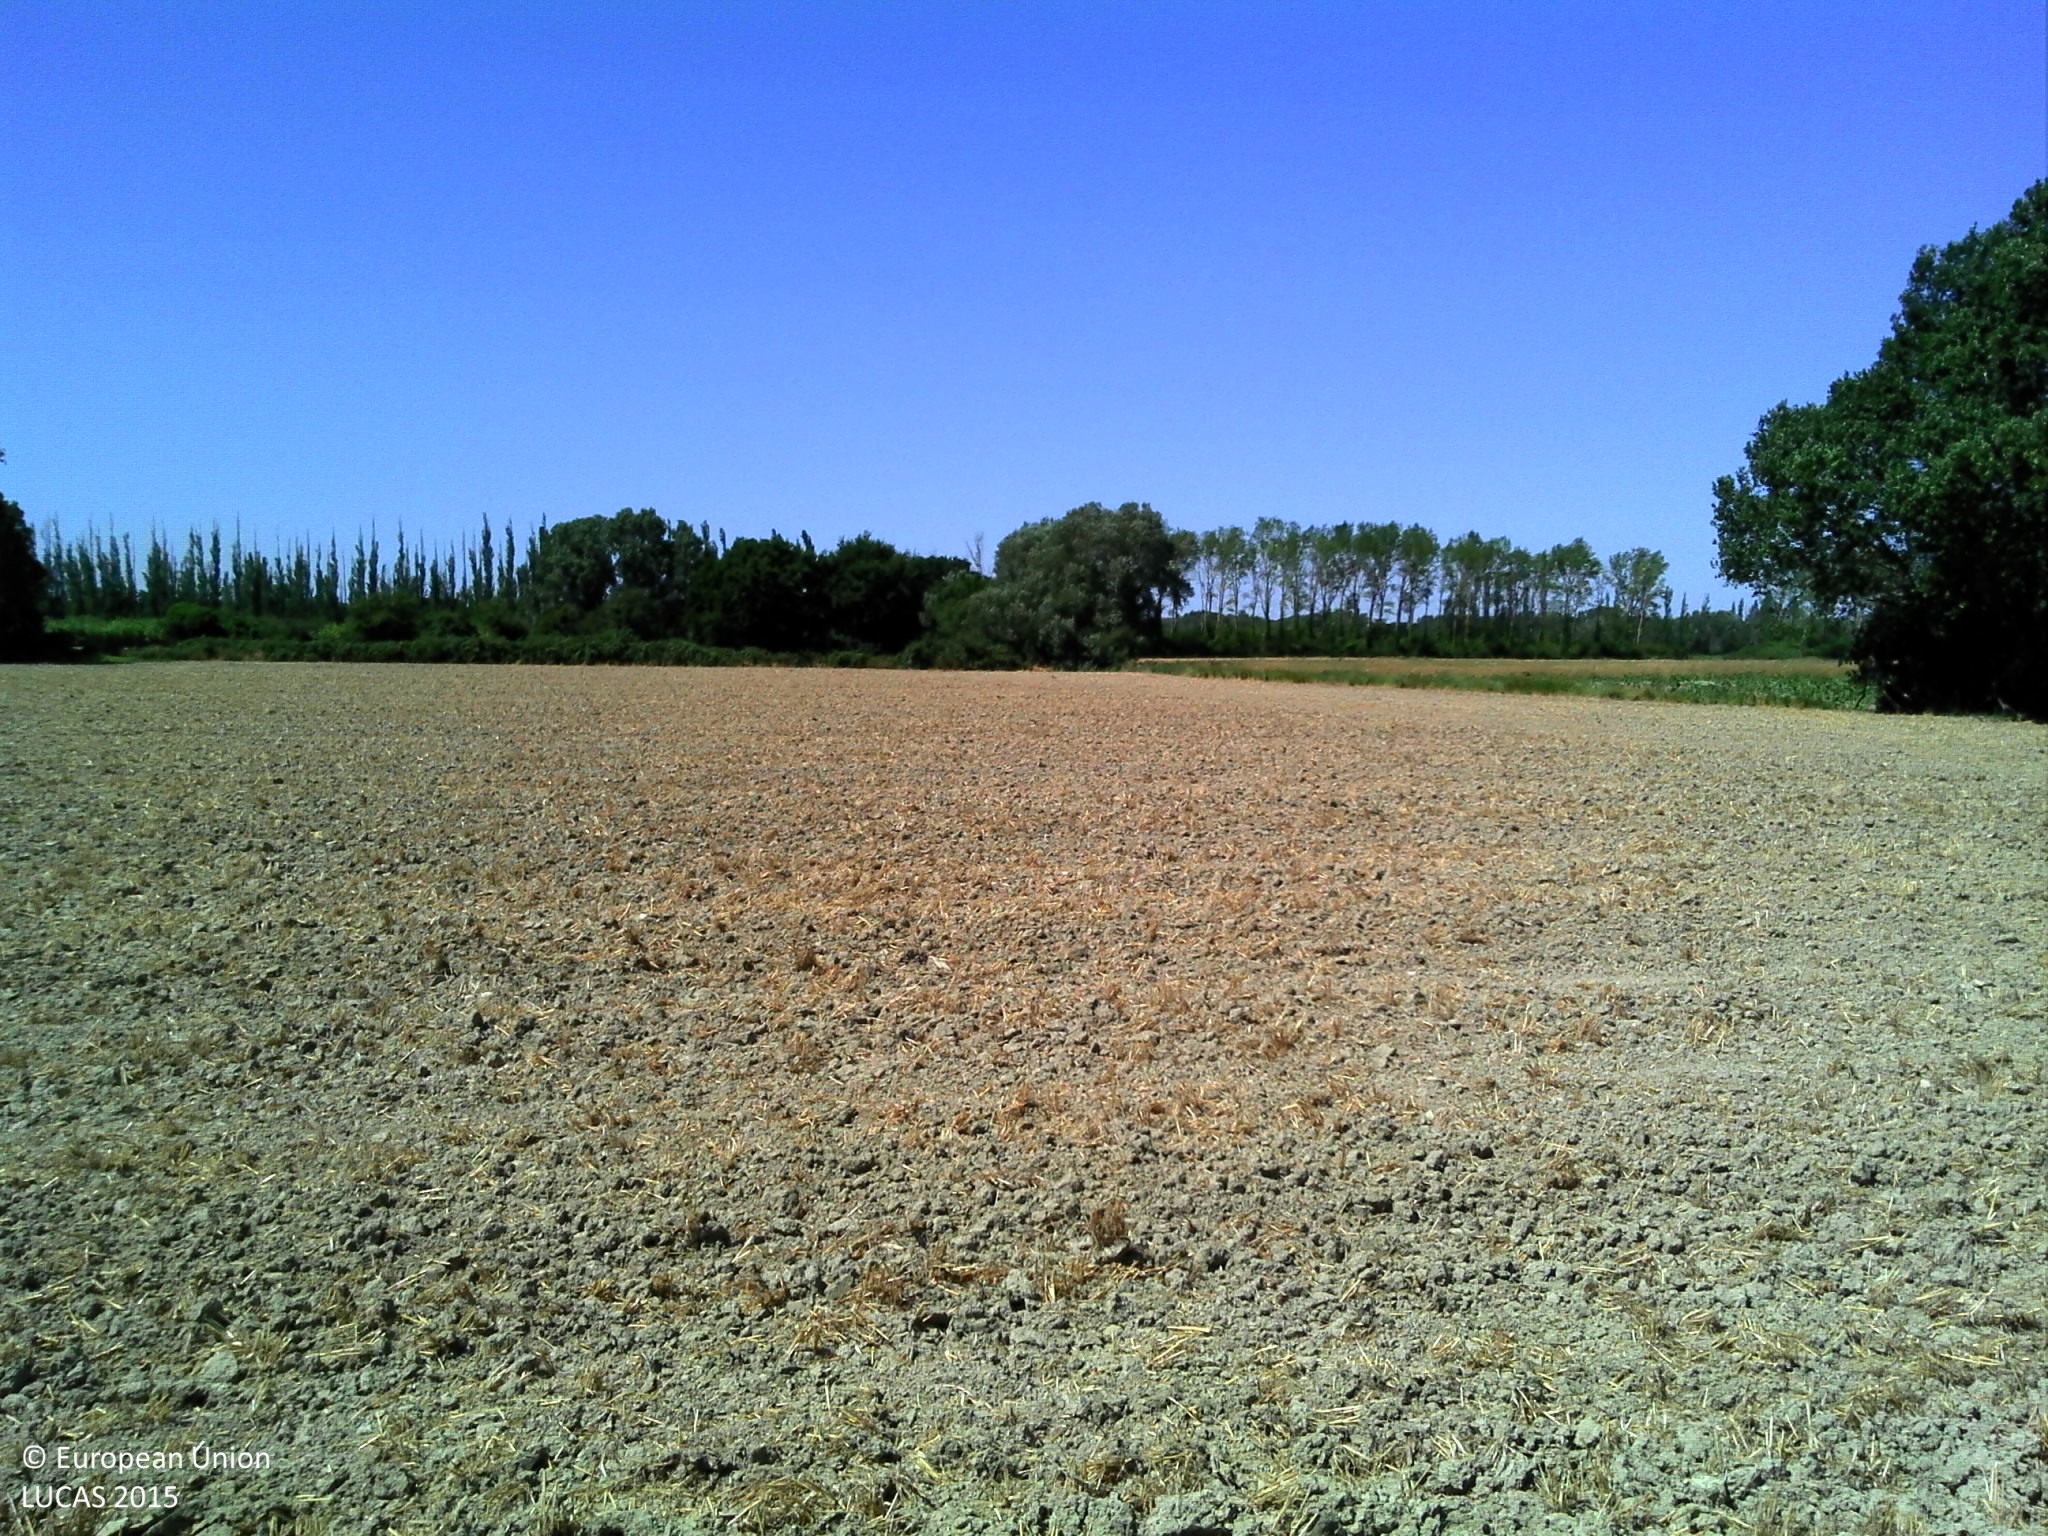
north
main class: Cropland
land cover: Durum wheat
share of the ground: > 75 %
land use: Agriculture (excluding fallow land and kitchen gardens)
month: July
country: FR
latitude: 44.1271
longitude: 4.7465
